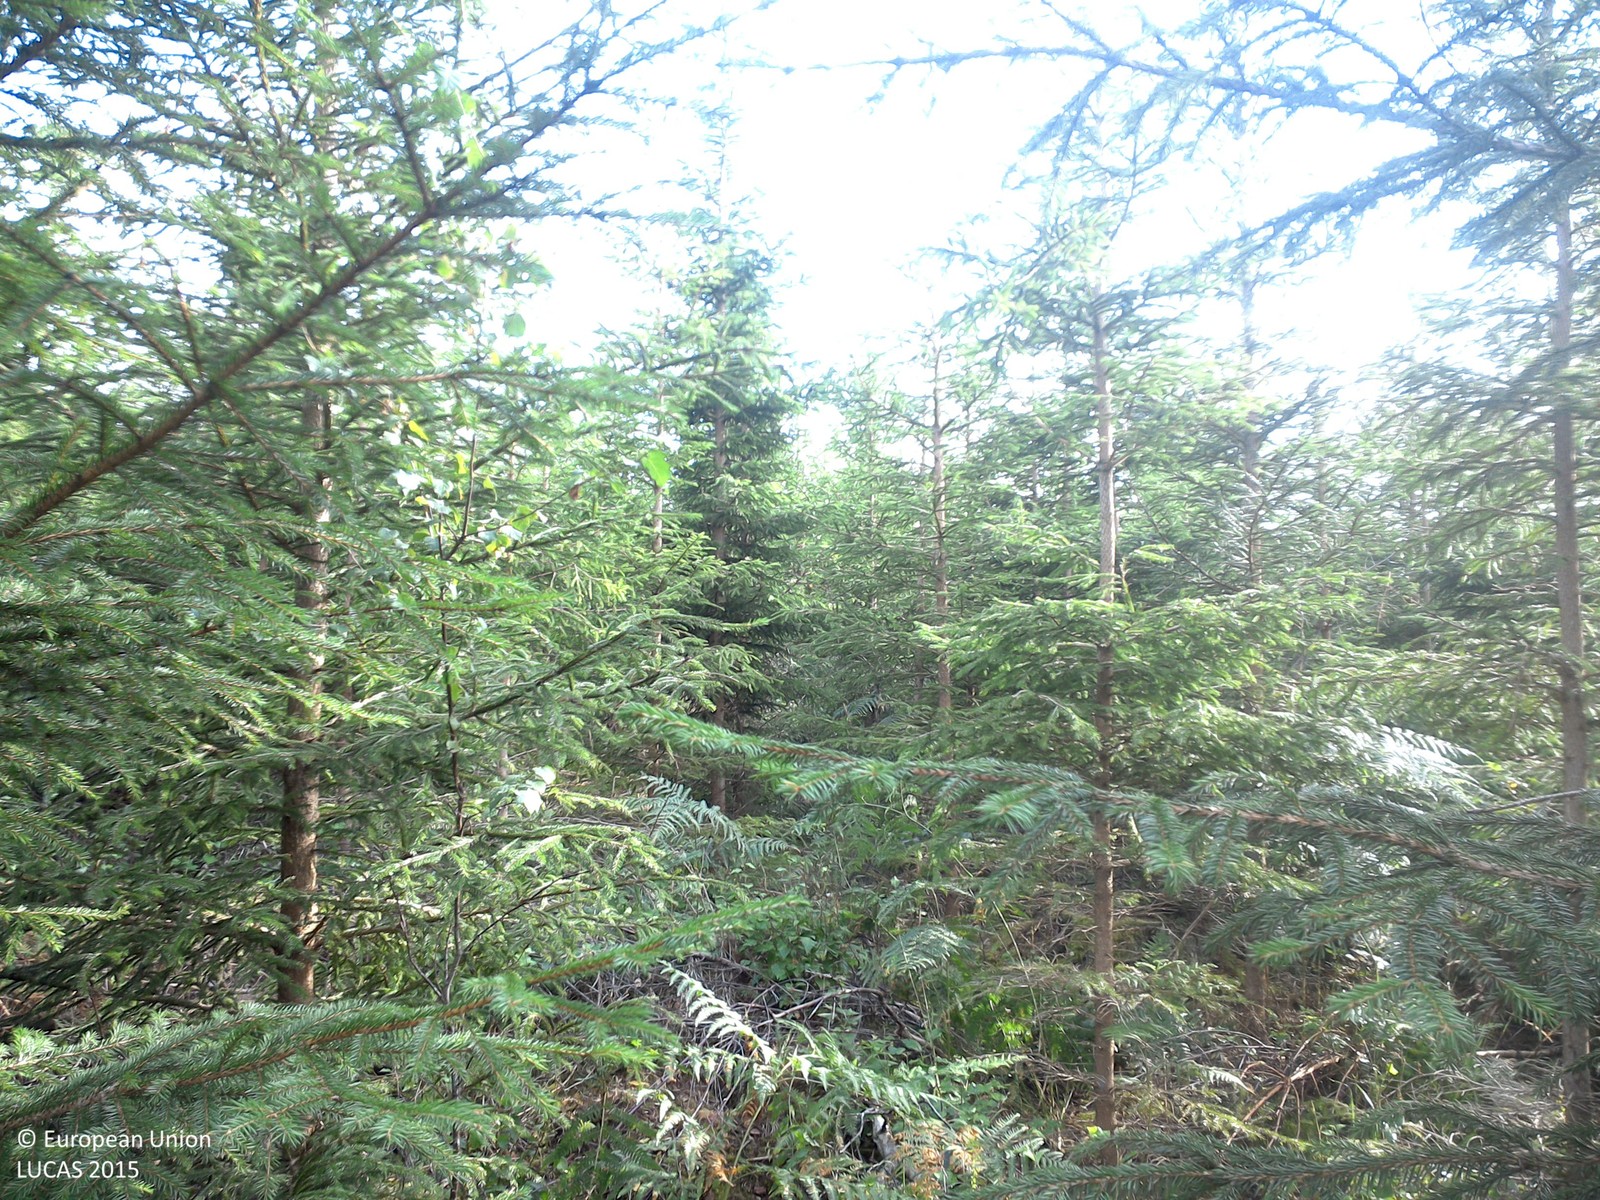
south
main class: Woodland
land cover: Spruce dominated coniferous woodland
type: boreal forest
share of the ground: 50 - 75 %
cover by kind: coniferous forest trees 75 %, herbaceous plants 20 %, lichens and mosses 5 %
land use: Forestry
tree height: < 5 m
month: August
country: SE
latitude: 57.7908
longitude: 15.2944
